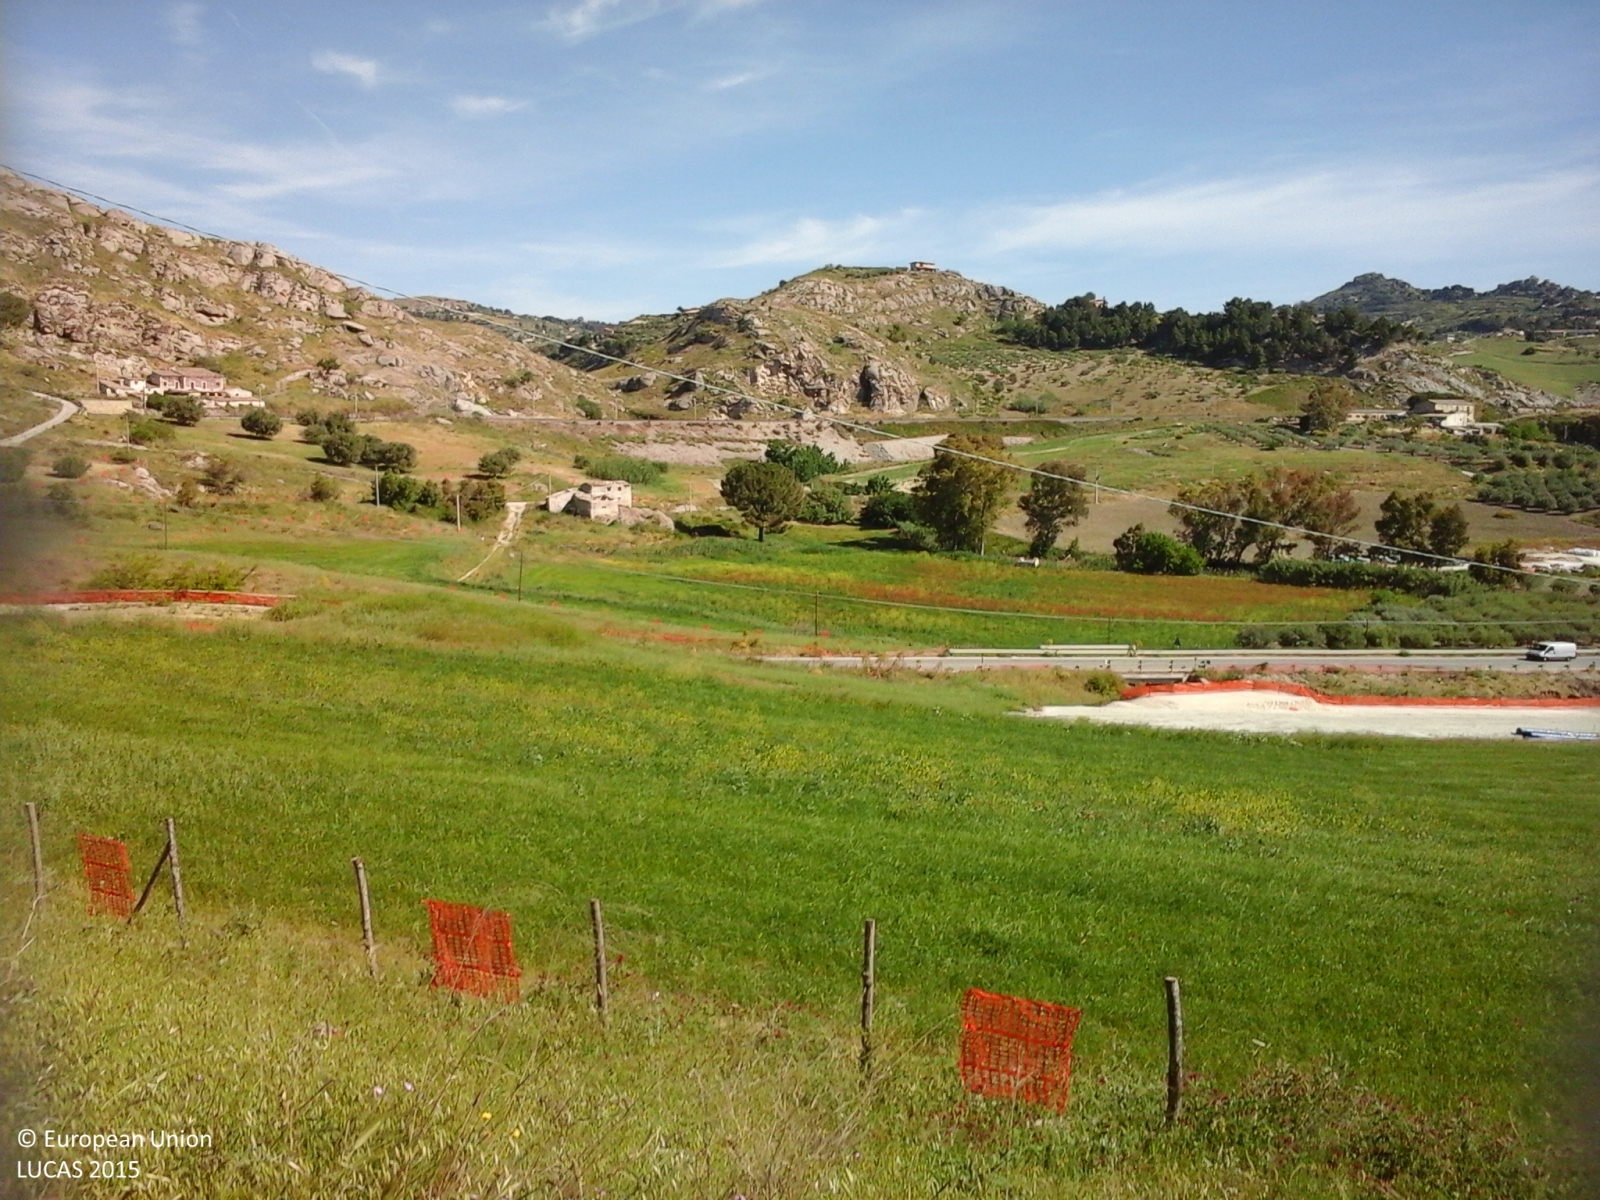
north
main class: Cropland
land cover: Olive groves
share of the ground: > 75 %
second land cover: Spontaneously vegetated surfaces
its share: > 75 %
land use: Agriculture (excluding fallow land and kitchen gardens)
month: May
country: IT
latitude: 37.4470
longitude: 13.9602
